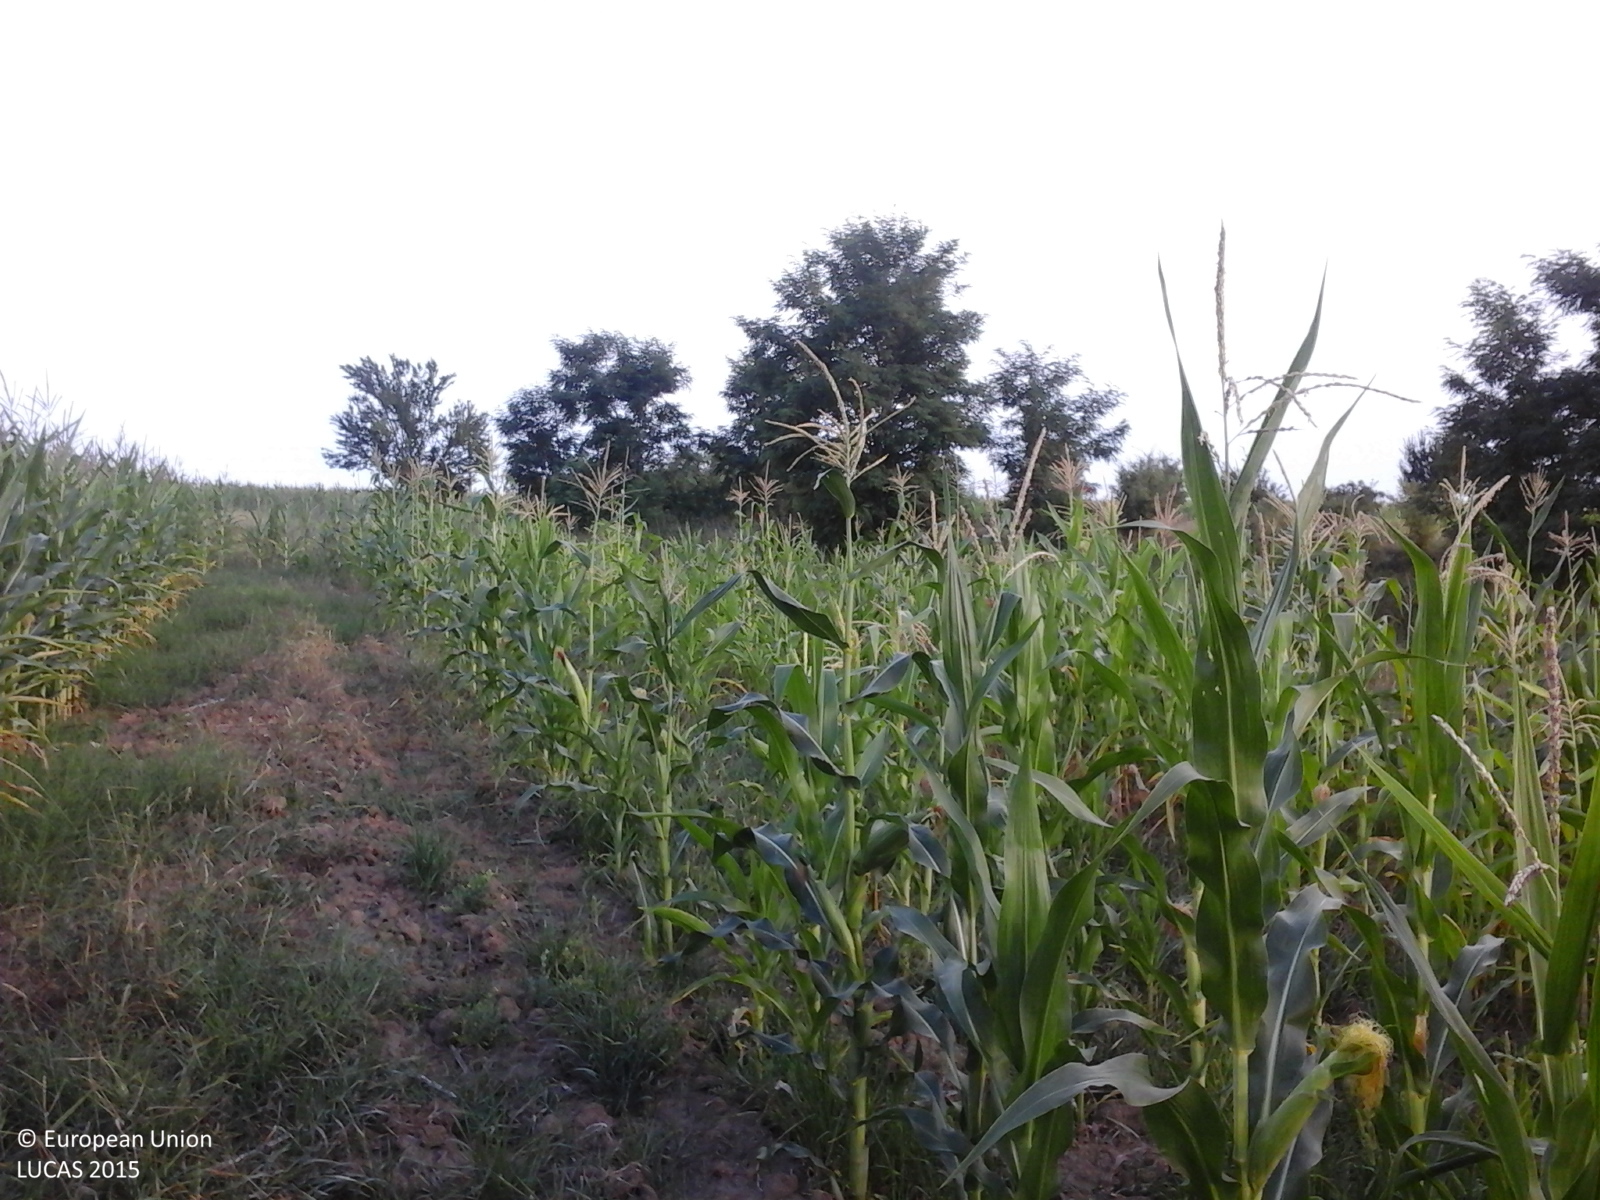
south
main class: Cropland
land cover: Maize
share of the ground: > 75 %
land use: Agriculture (excluding fallow land and kitchen gardens)
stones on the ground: < 10 %
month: July
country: RO
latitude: 46.2315
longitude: 26.7489
